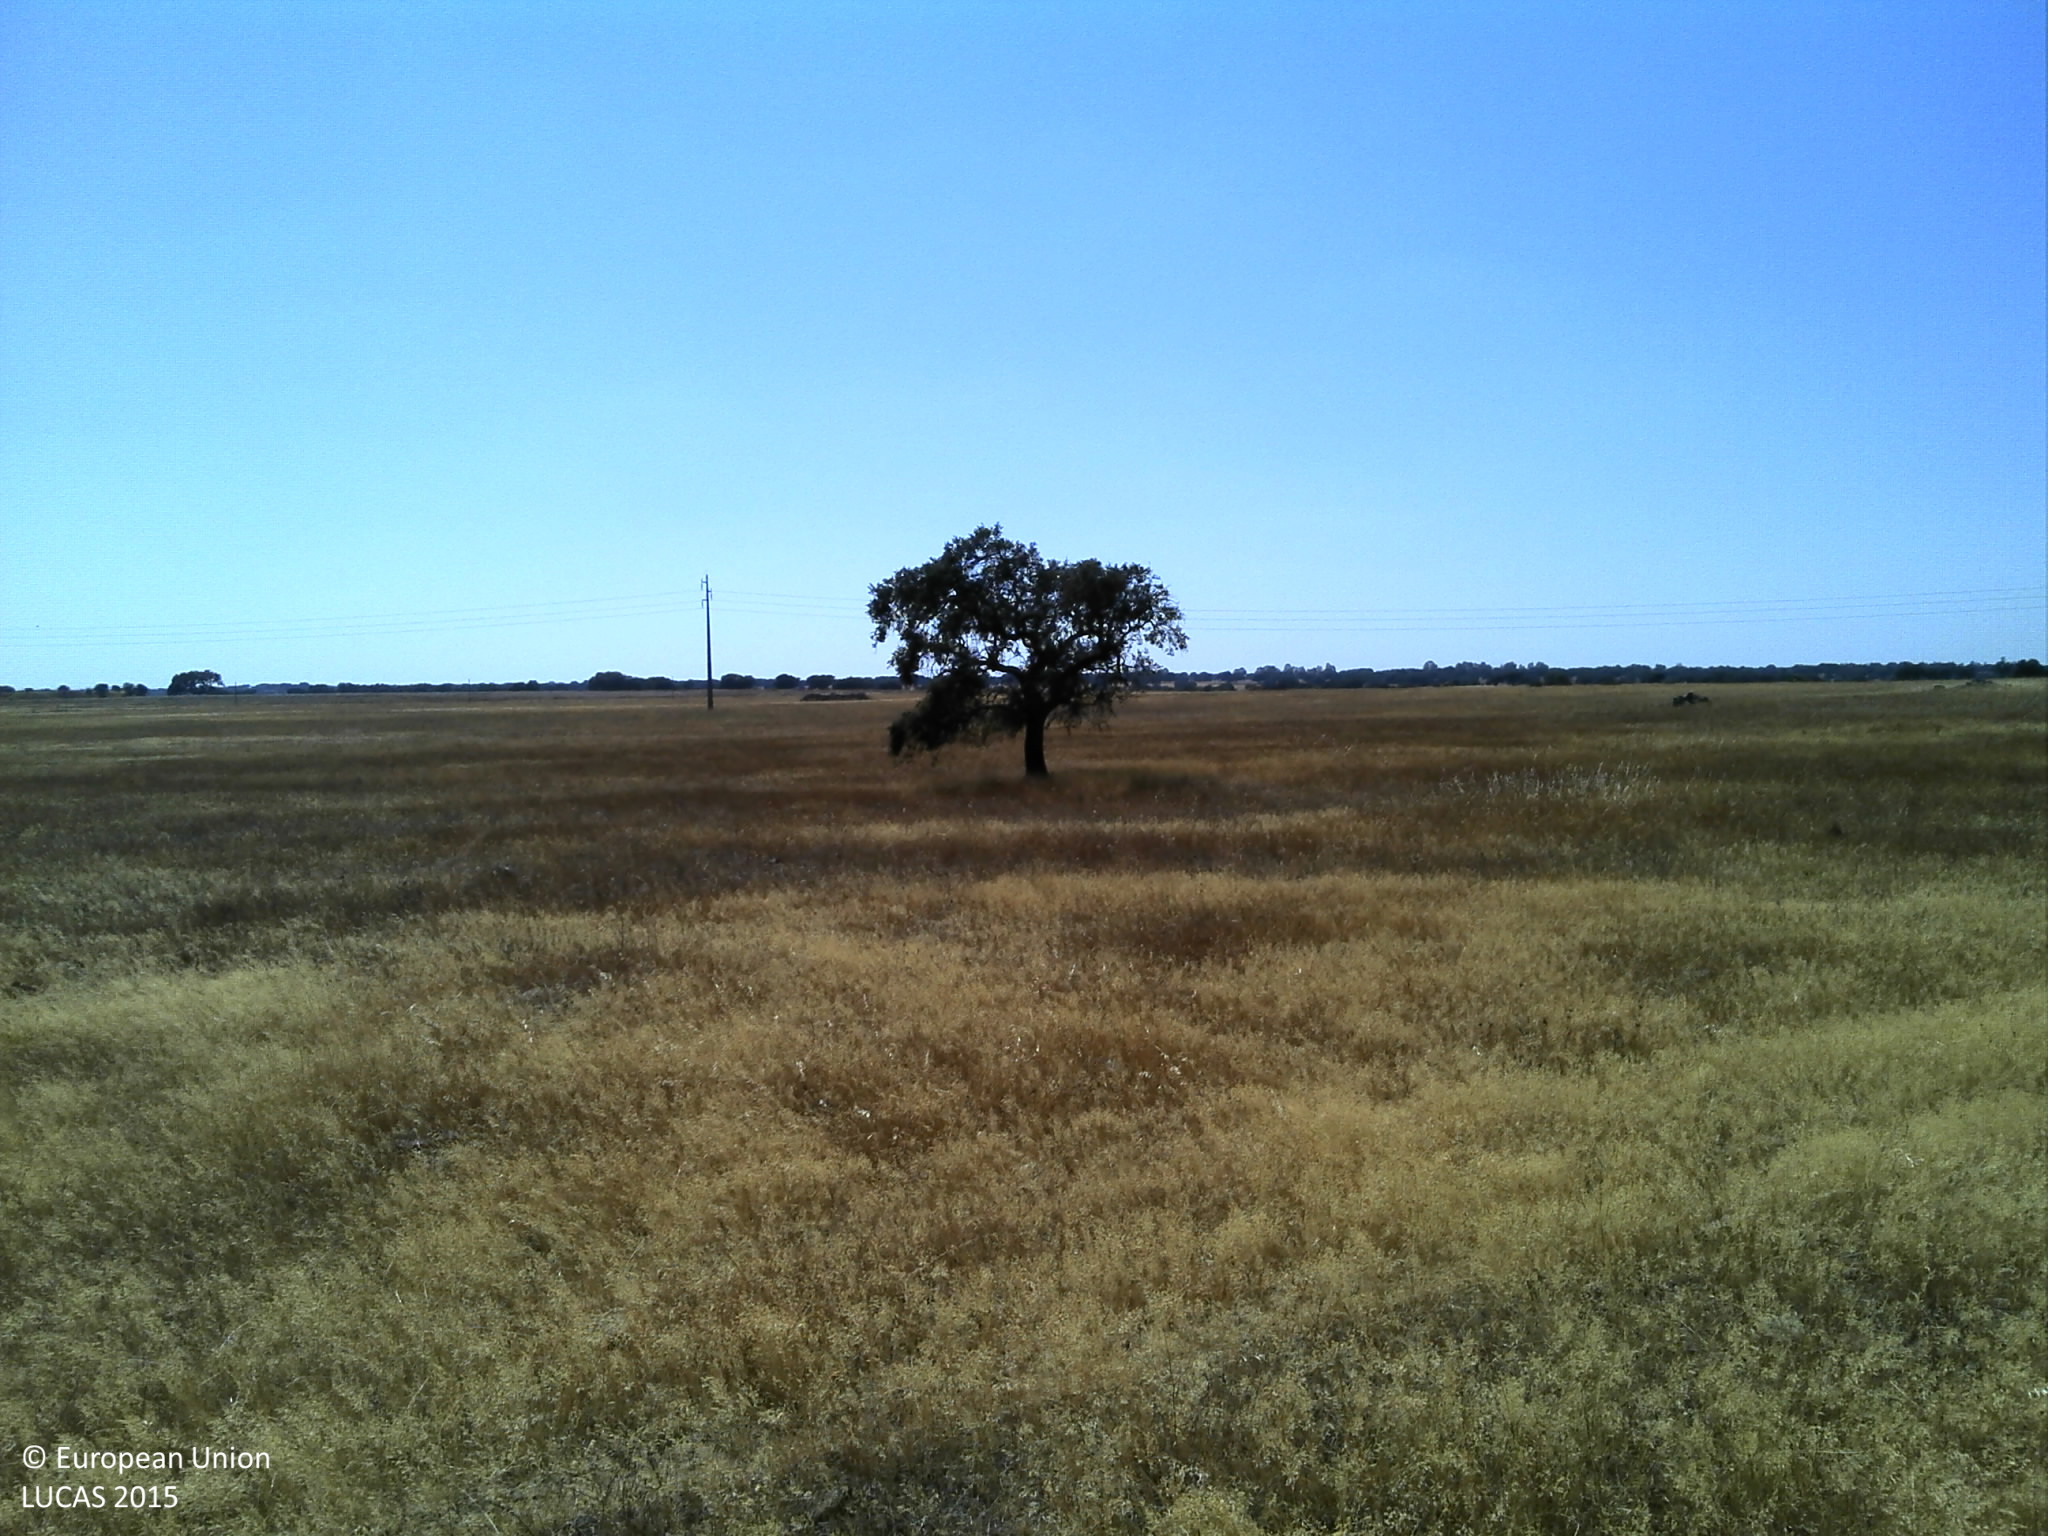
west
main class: Grassland
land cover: Grassland without tree/shrub cover
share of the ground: > 75 %
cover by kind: herbaceous plants 85 %, unconsolidated bare surface 15 %
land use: Agriculture (excluding fallow land and kitchen gardens)
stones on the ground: < 10 %
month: June
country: PT
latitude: 38.2084
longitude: -8.0458
